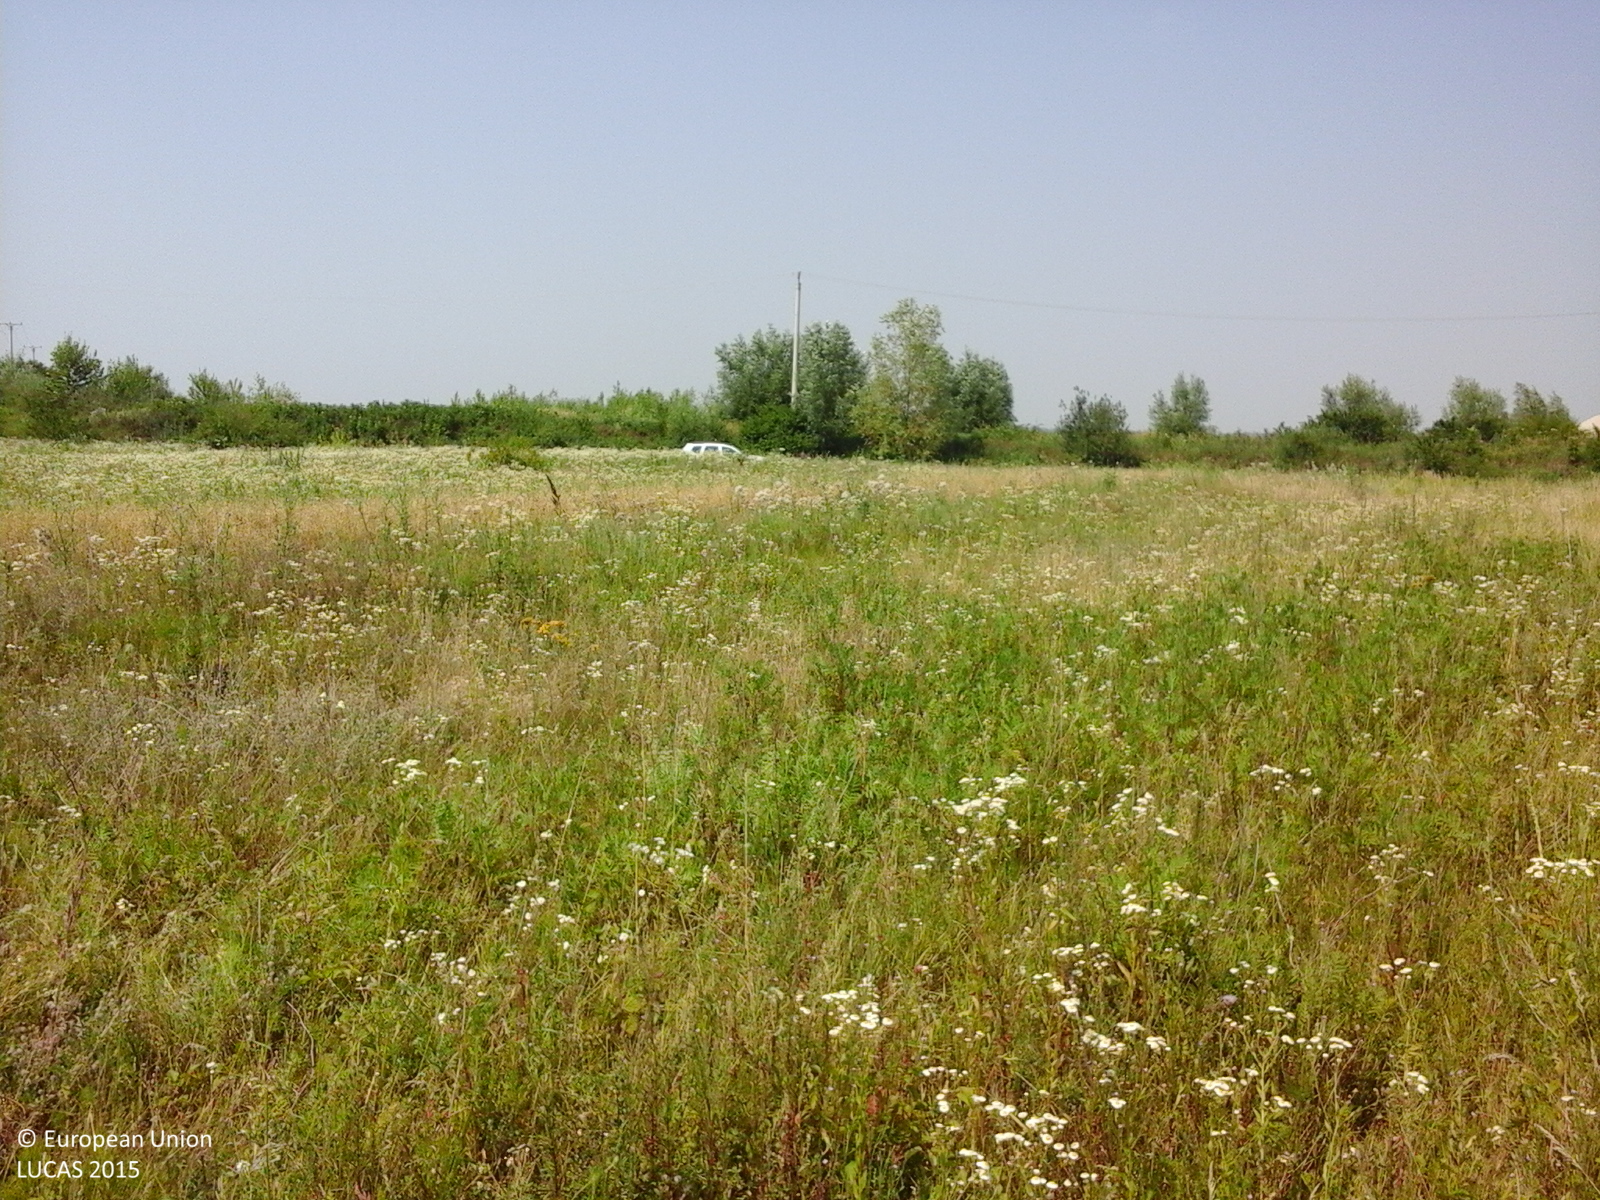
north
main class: Grassland
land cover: Spontaneously vegetated surfaces
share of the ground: > 75 %
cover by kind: herbaceous plants 100 %
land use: Fallow land
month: July
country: RO
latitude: 44.5497
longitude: 25.6412
